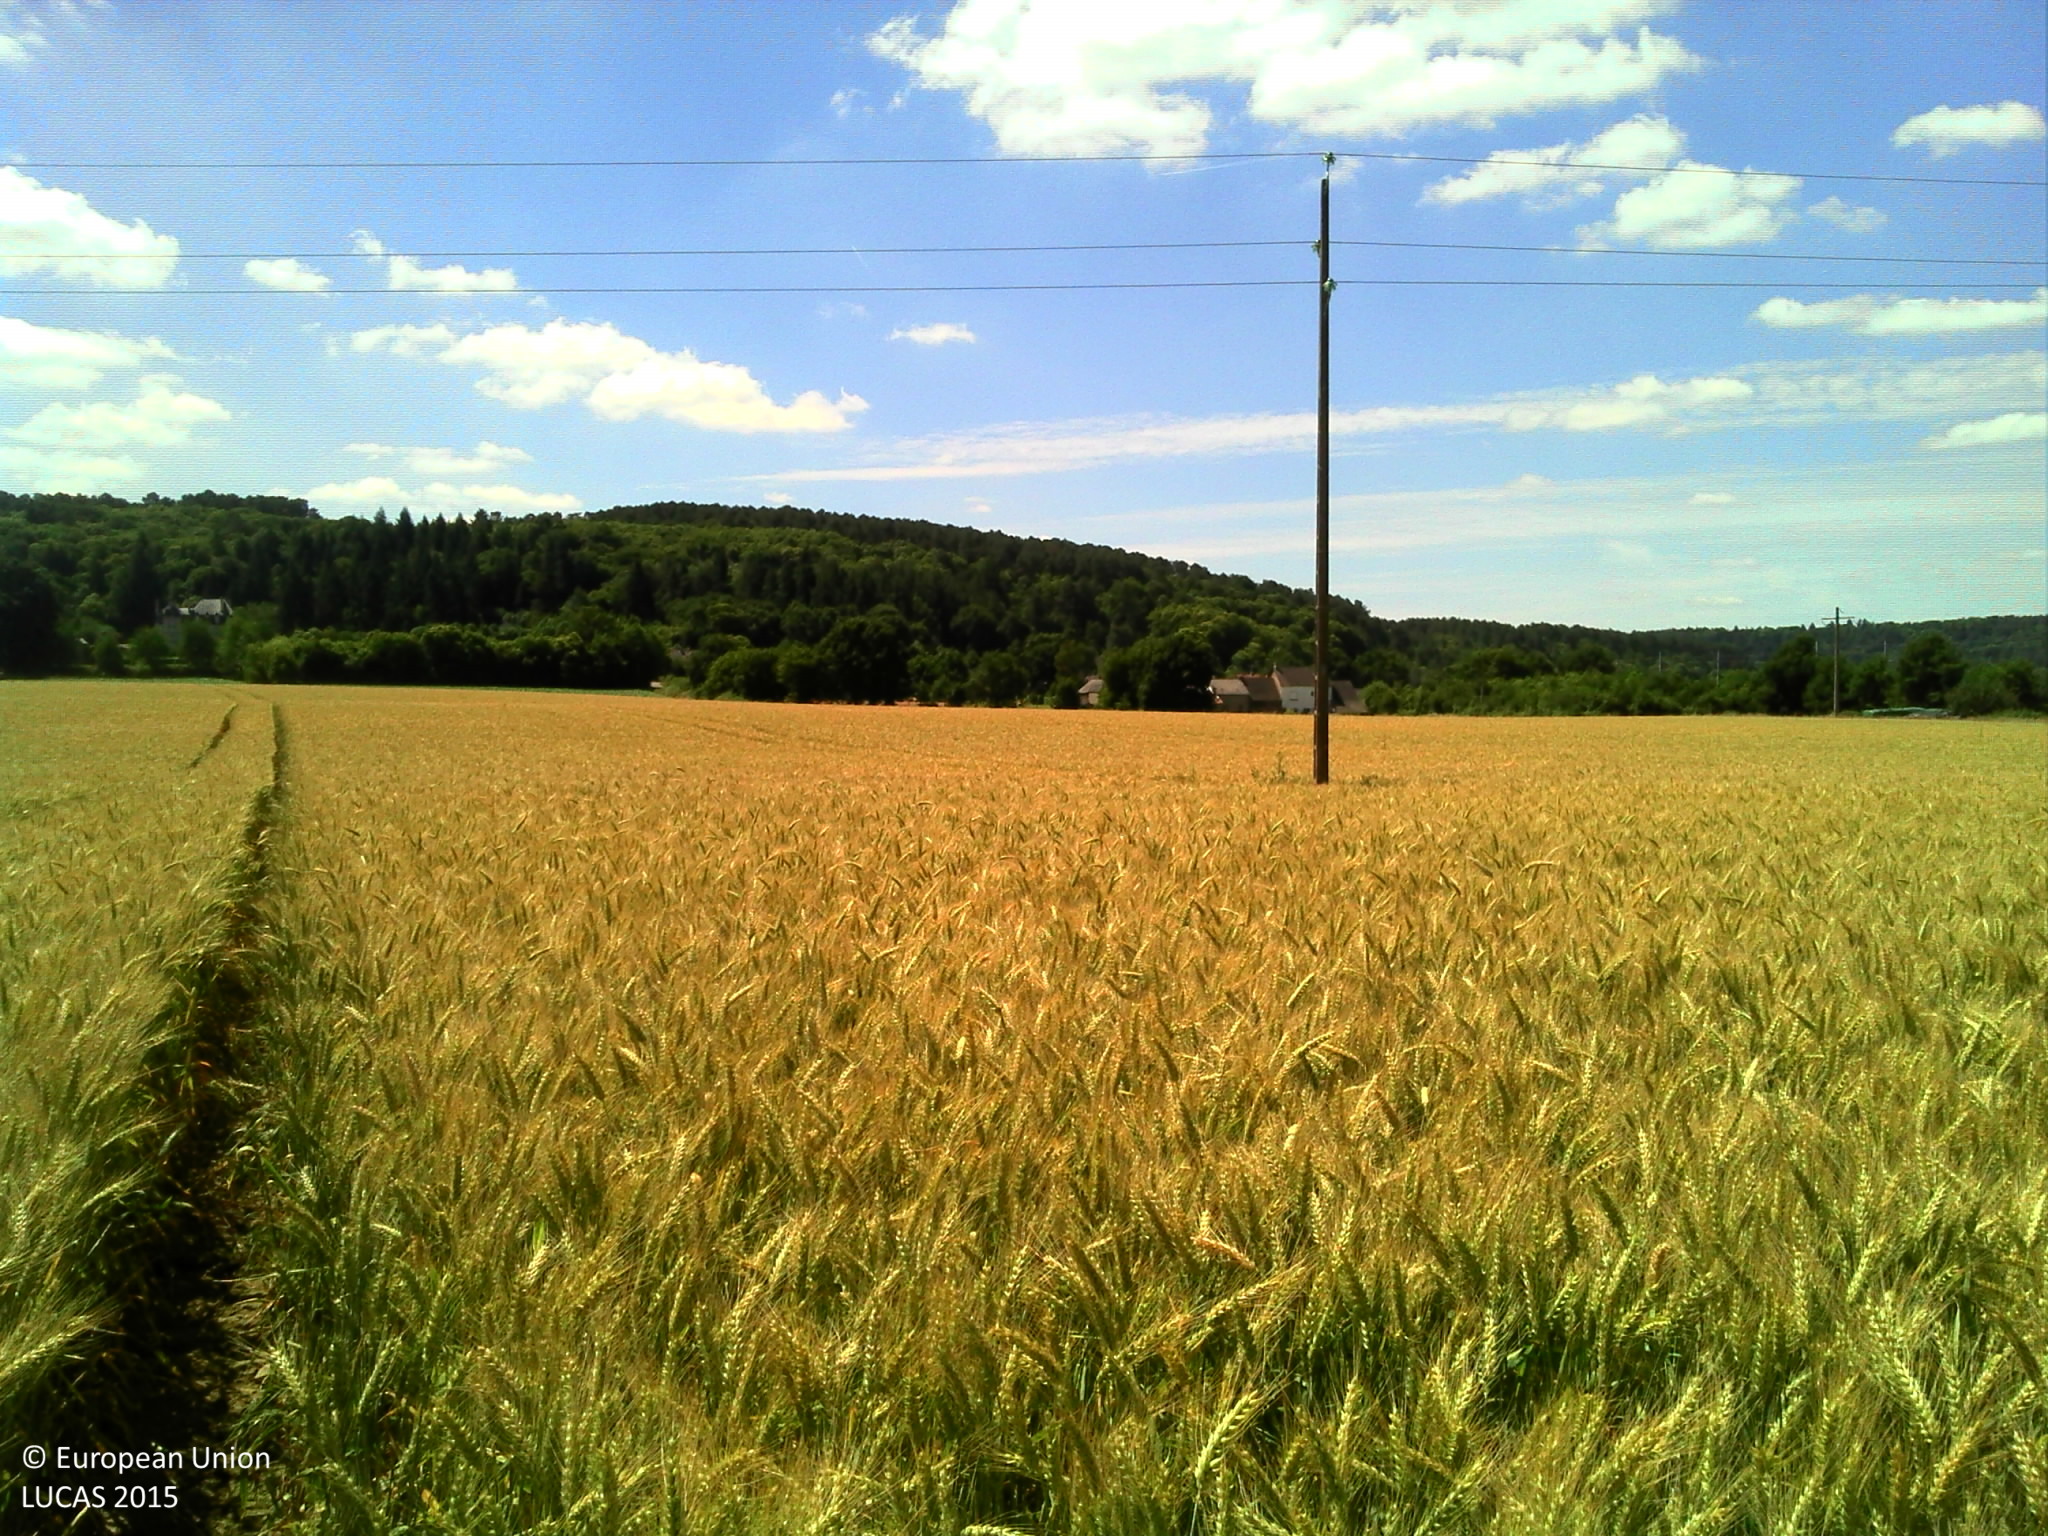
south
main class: Cropland
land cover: Common wheat
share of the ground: > 75 %
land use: Agriculture (excluding fallow land and kitchen gardens)
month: June
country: FR
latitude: 47.7836
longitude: -1.8341
